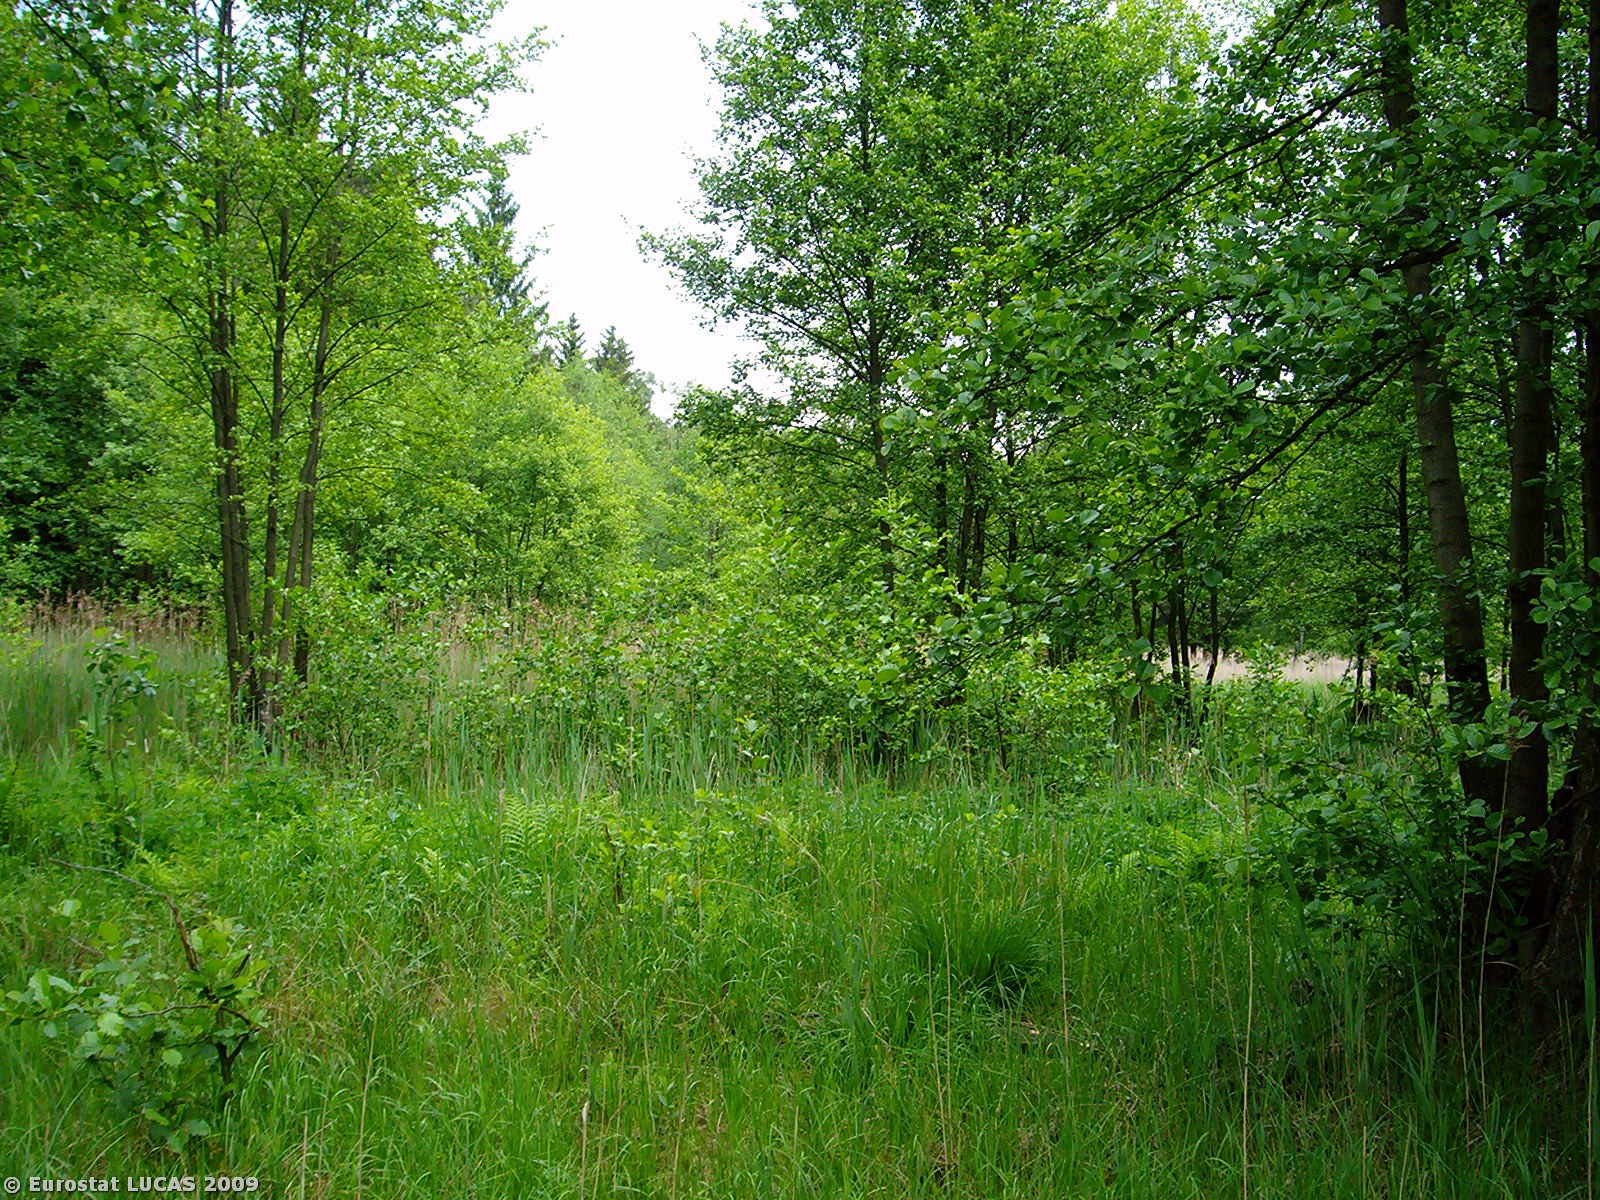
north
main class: Woodland
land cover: Broadleaved woodland
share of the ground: 50 - 75 %
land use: Forestry
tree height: < 5 m
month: May
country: PL
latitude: 52.6210
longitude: 16.3734
